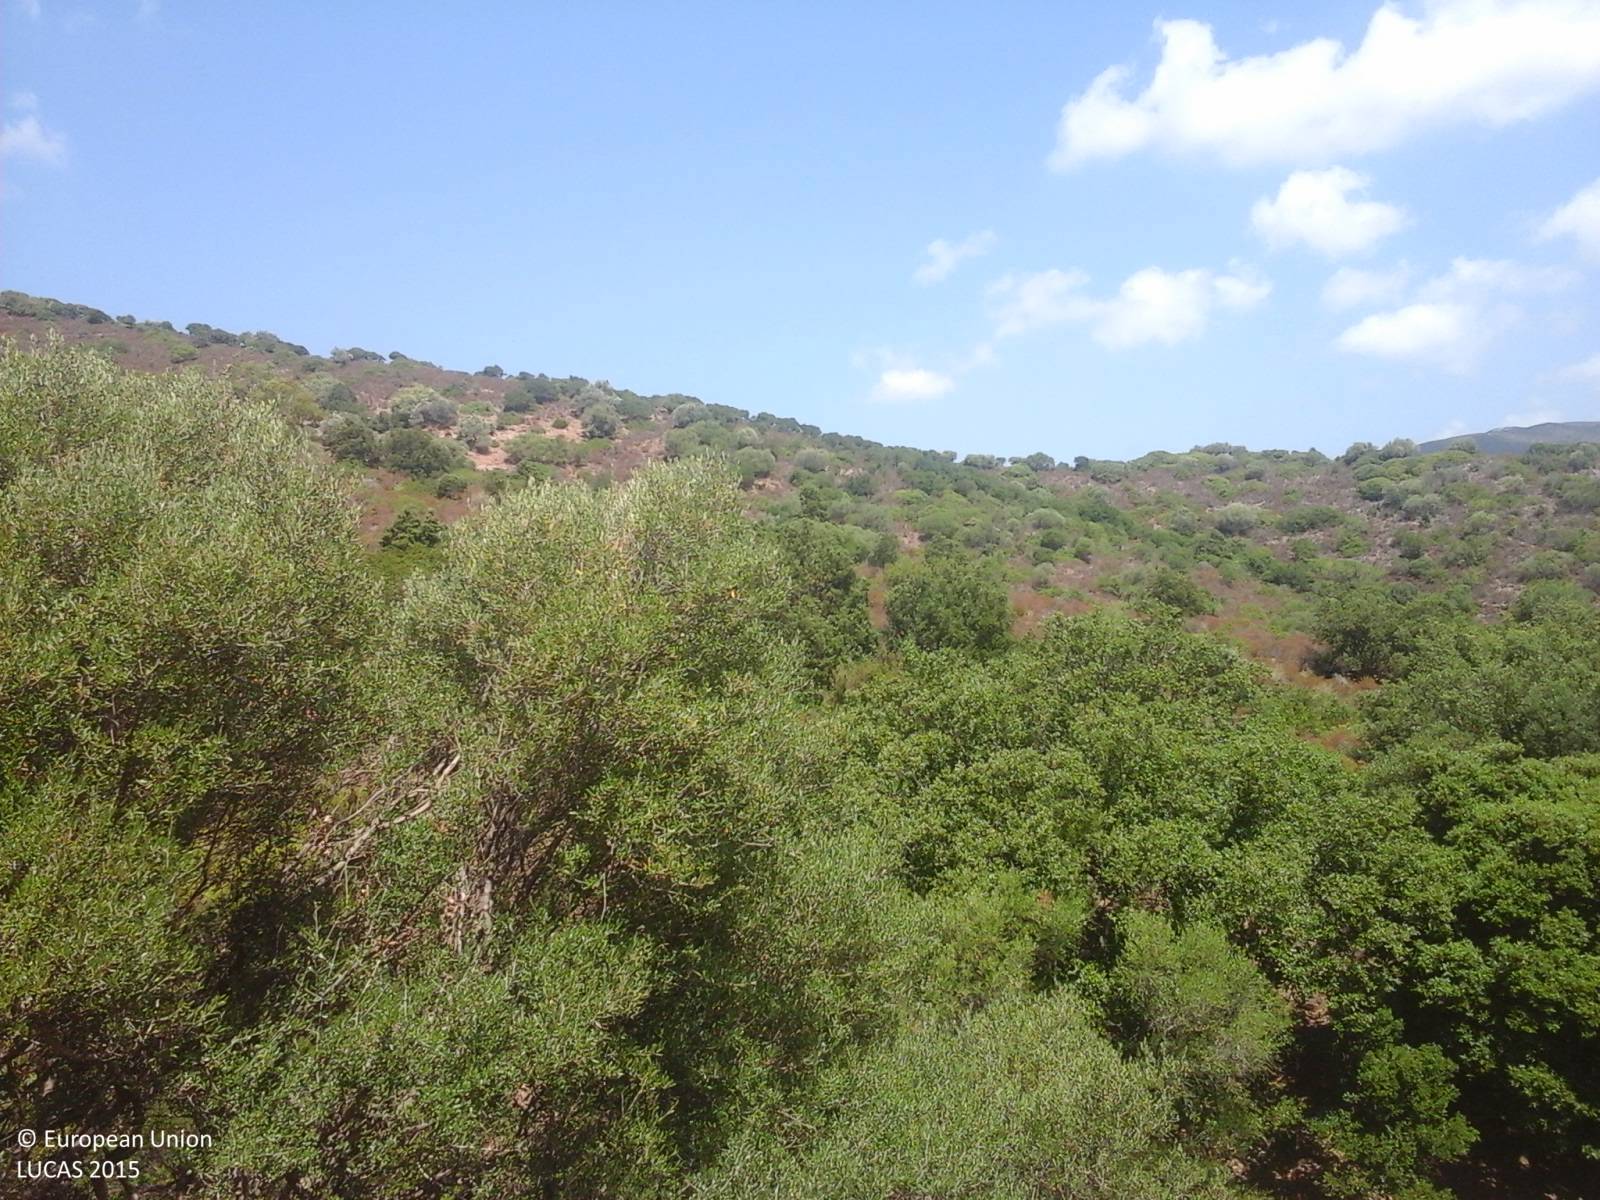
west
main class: Shrubland
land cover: Shrubland with sparse tree cover
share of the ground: > 75 %
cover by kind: shrubs 75 %, herbaceous plants 15 %, broadleaved forest trees 5 %, unconsolidated bare surface 5 %
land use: Agriculture (excluding fallow land and kitchen gardens)
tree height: < 5 m
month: July
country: IT
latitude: 39.4331
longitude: 9.5265
